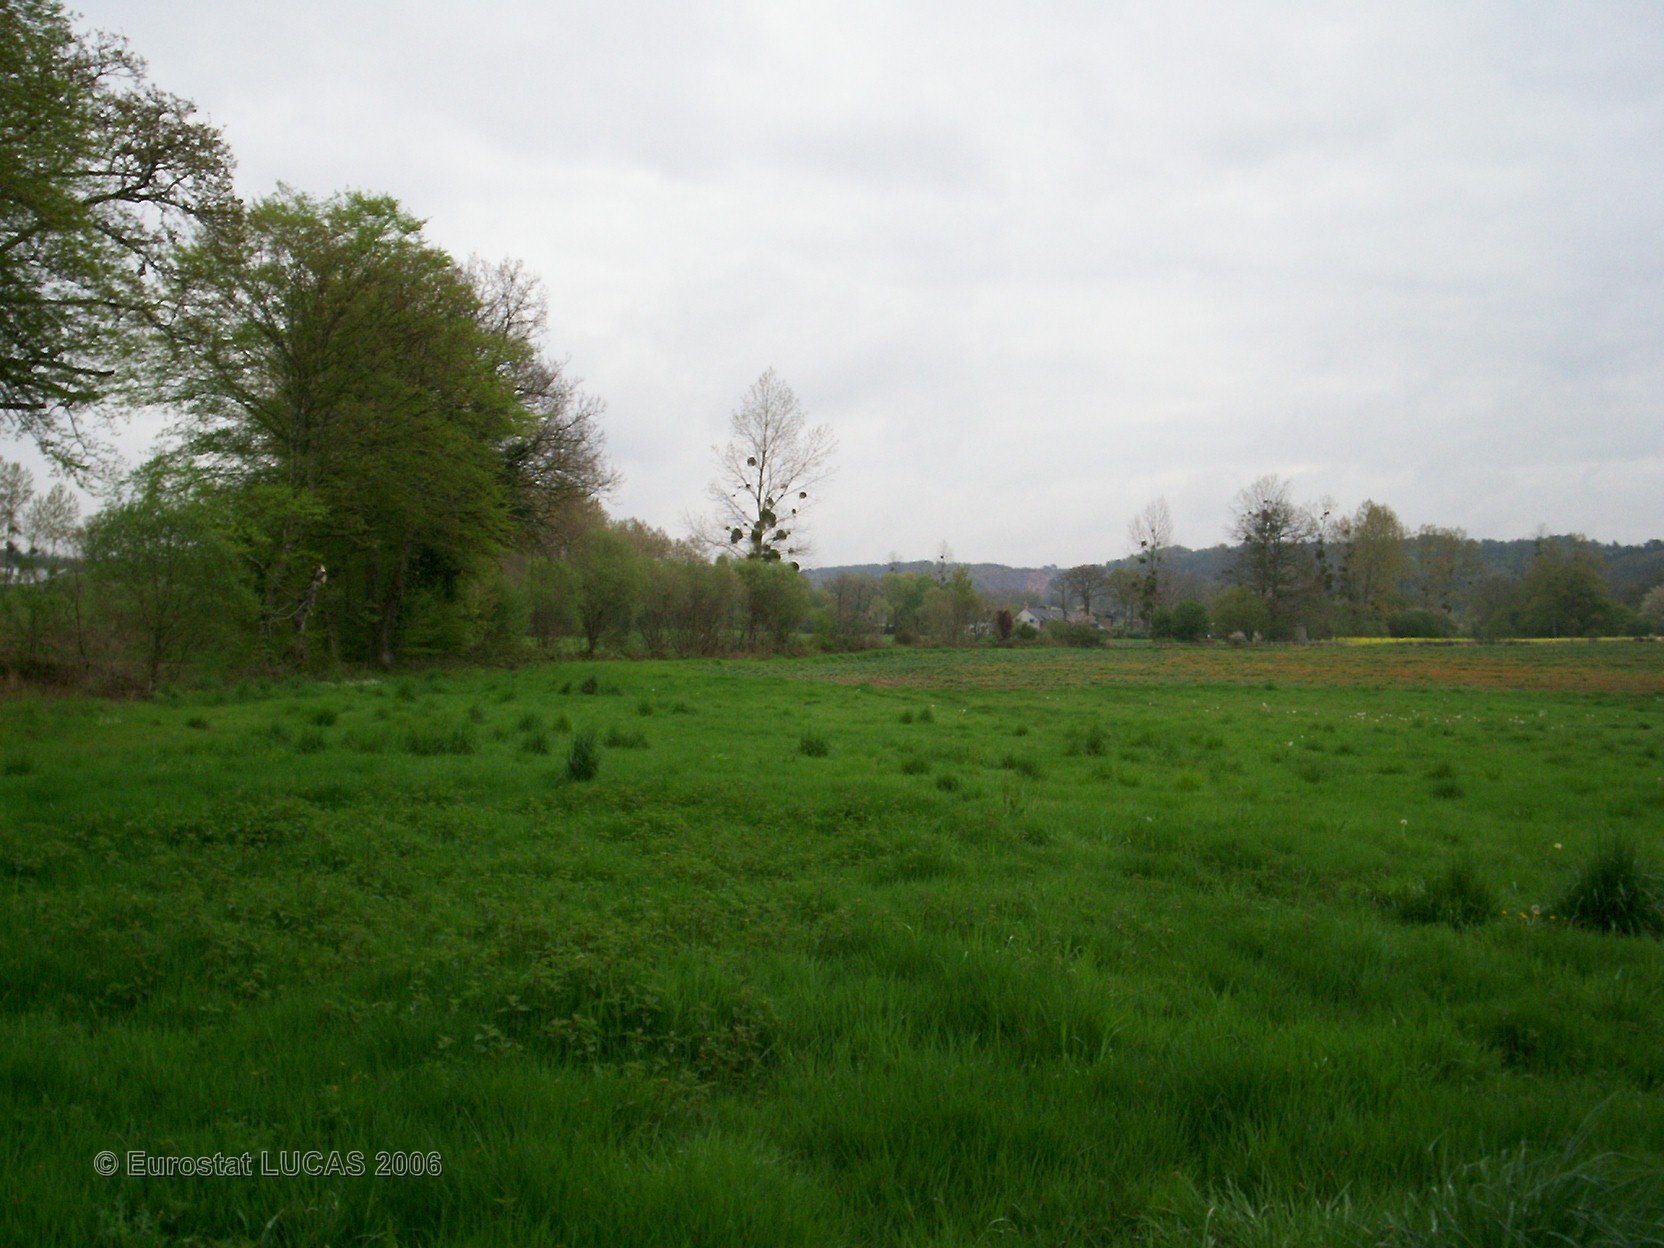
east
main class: Grassland
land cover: Grassland without tree/shrub cover
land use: Agriculture (excluding fallow land and kitchen gardens)
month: April
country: FR
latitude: 48.0055
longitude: -2.2943
